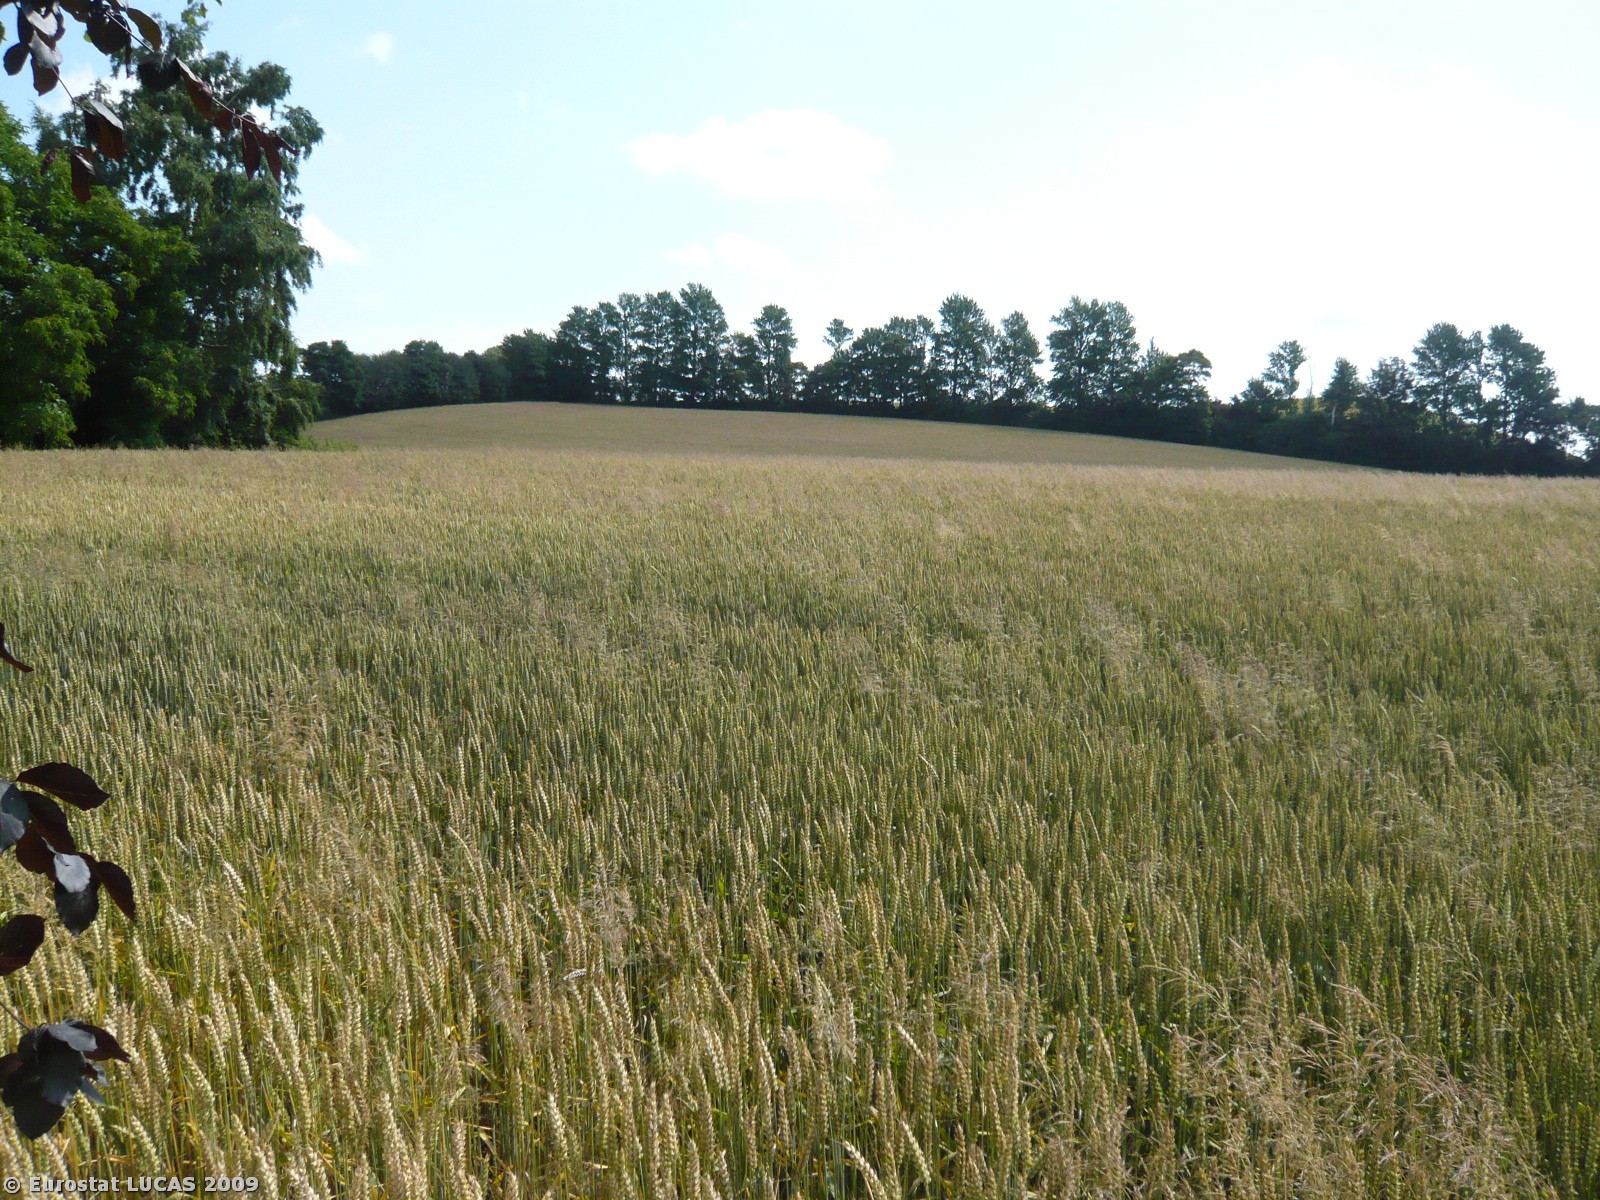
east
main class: Woodland
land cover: Broadleaved woodland
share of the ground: > 75 %
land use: Unused
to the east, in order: Common wheat; Broadleaved woodland; Grassland without tree/shrub cover; Arable land (only in case pi)
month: July
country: DK
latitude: 55.8013
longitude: 11.5140
